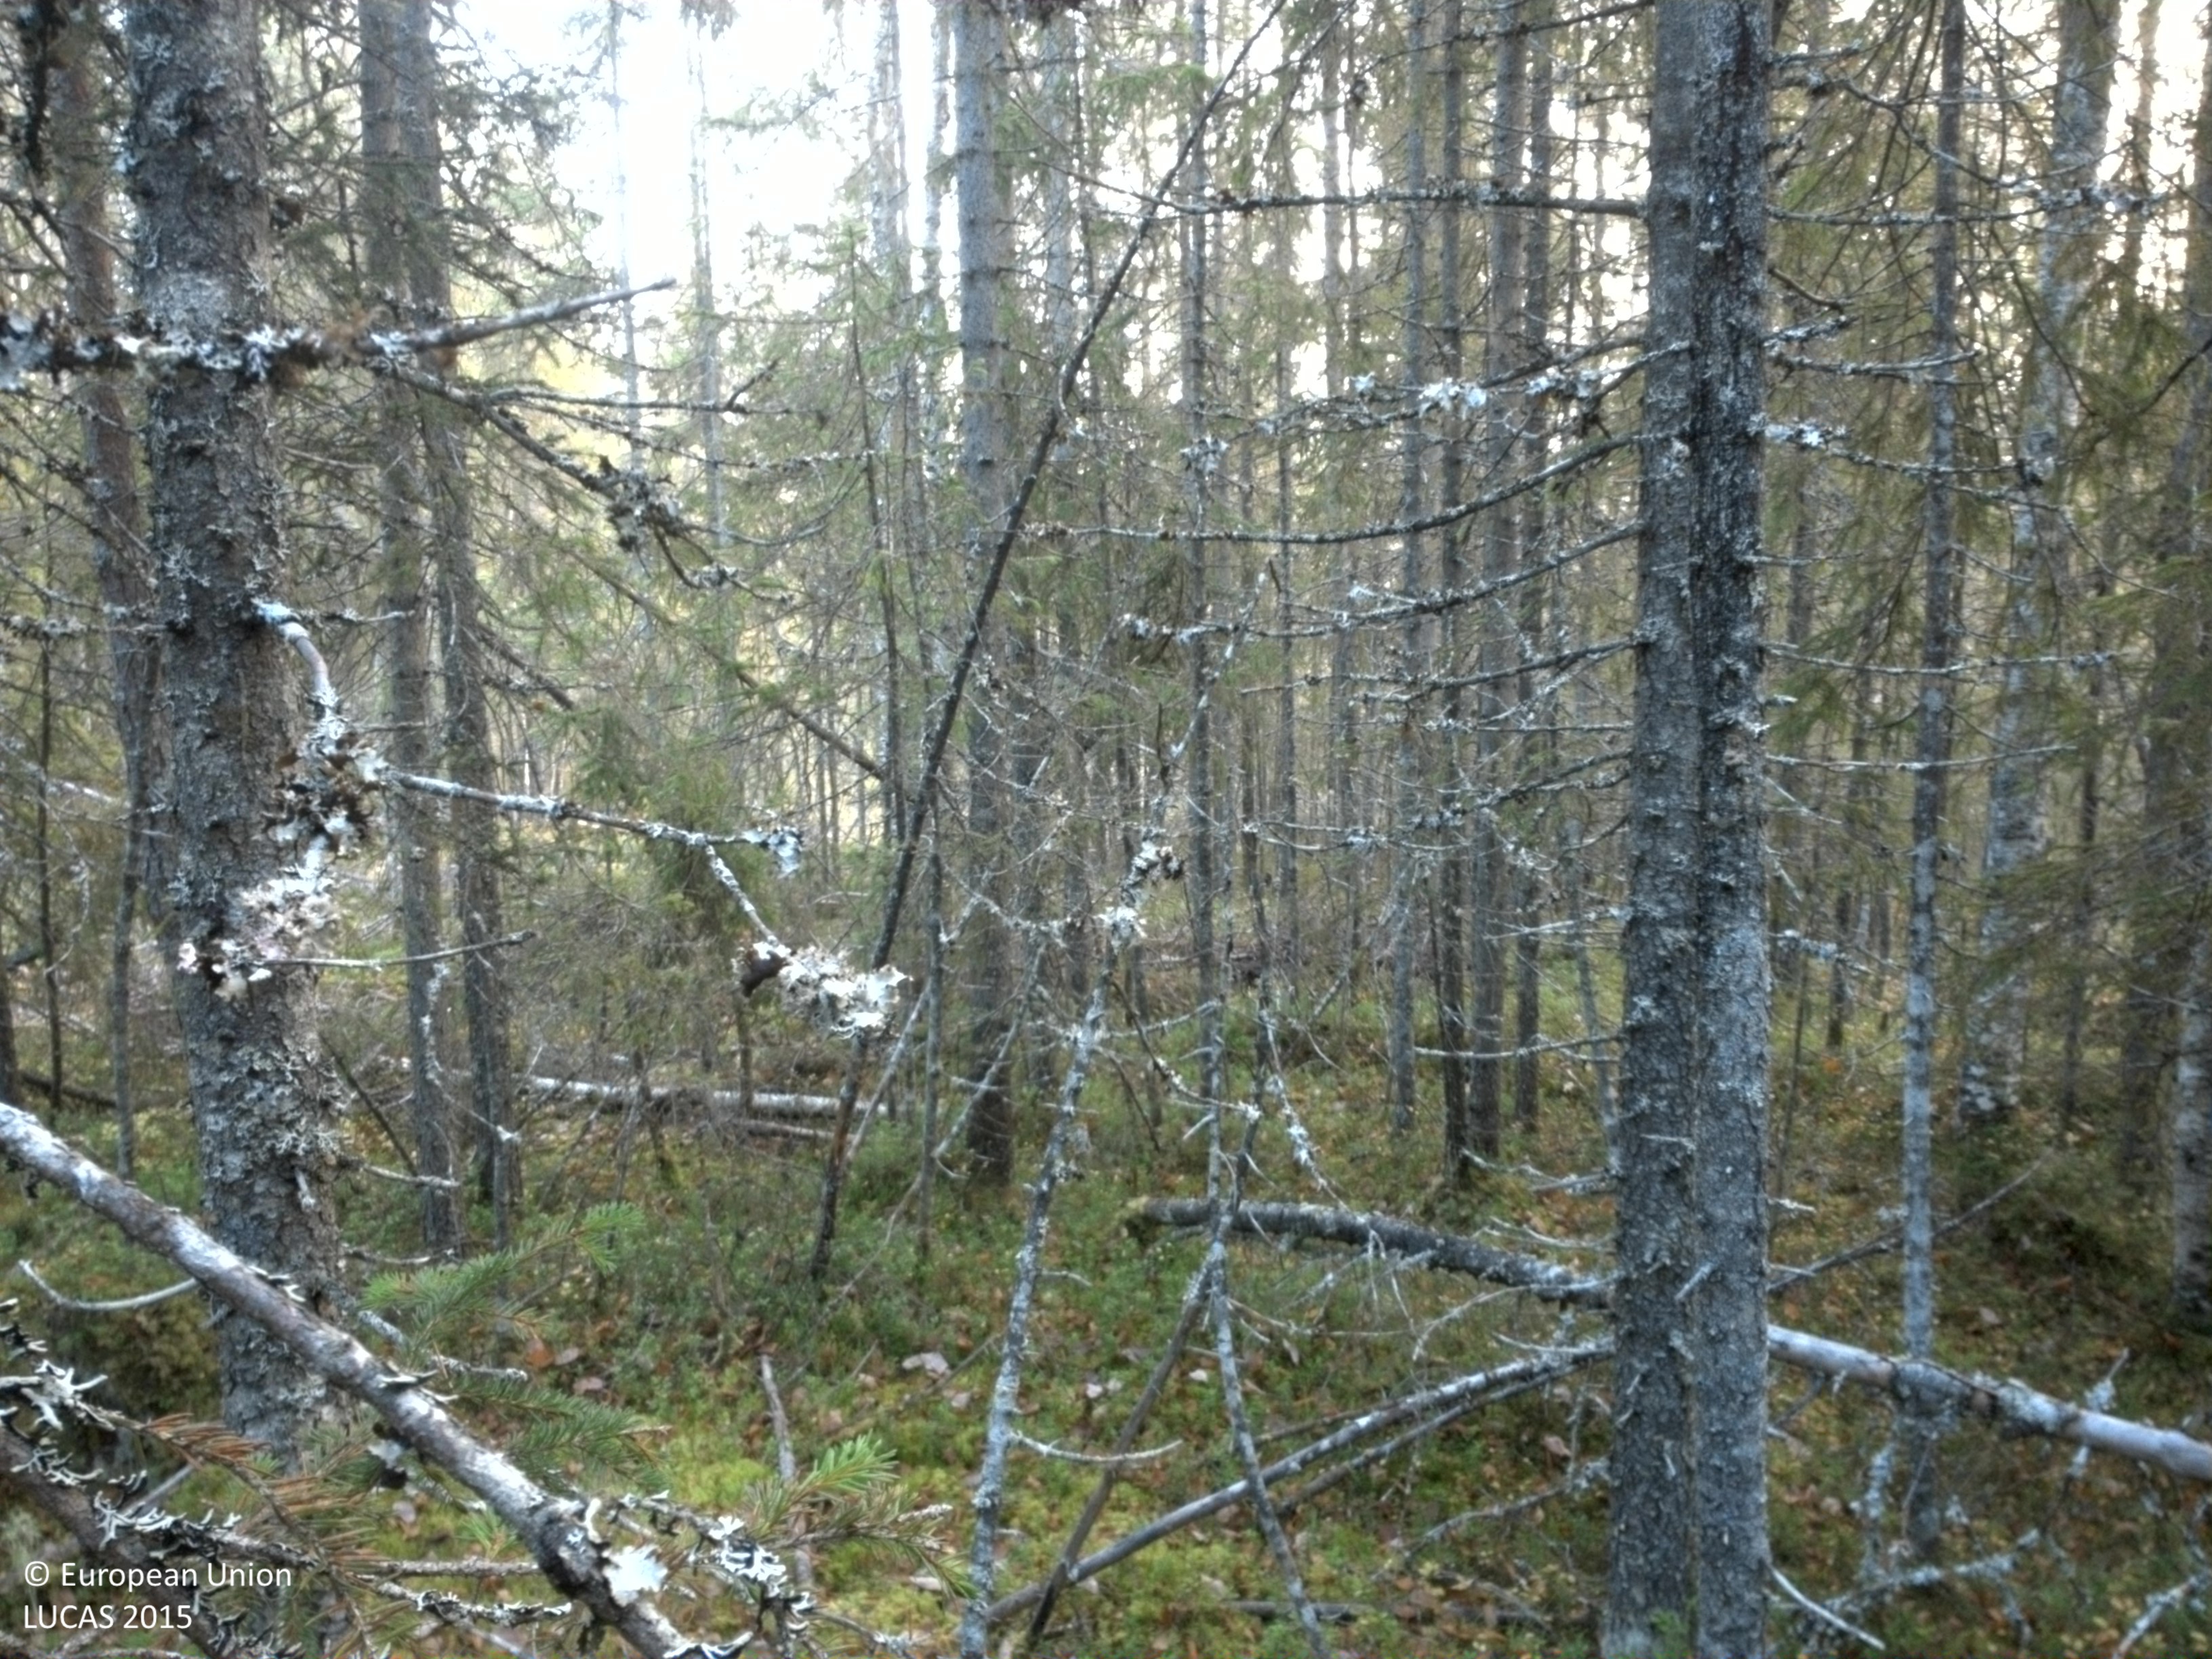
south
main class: Woodland
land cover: Spruce dominated coniferous woodland
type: boreal forest
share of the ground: 50 - 75 %
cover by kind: coniferous forest trees 65 %, shrubs 15 %, herbaceous plants 15 %, broadleaved forest trees 5 %
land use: Forestry
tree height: > 5 m
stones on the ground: < 10 %
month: October
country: SE
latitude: 64.5483
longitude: 16.6619
